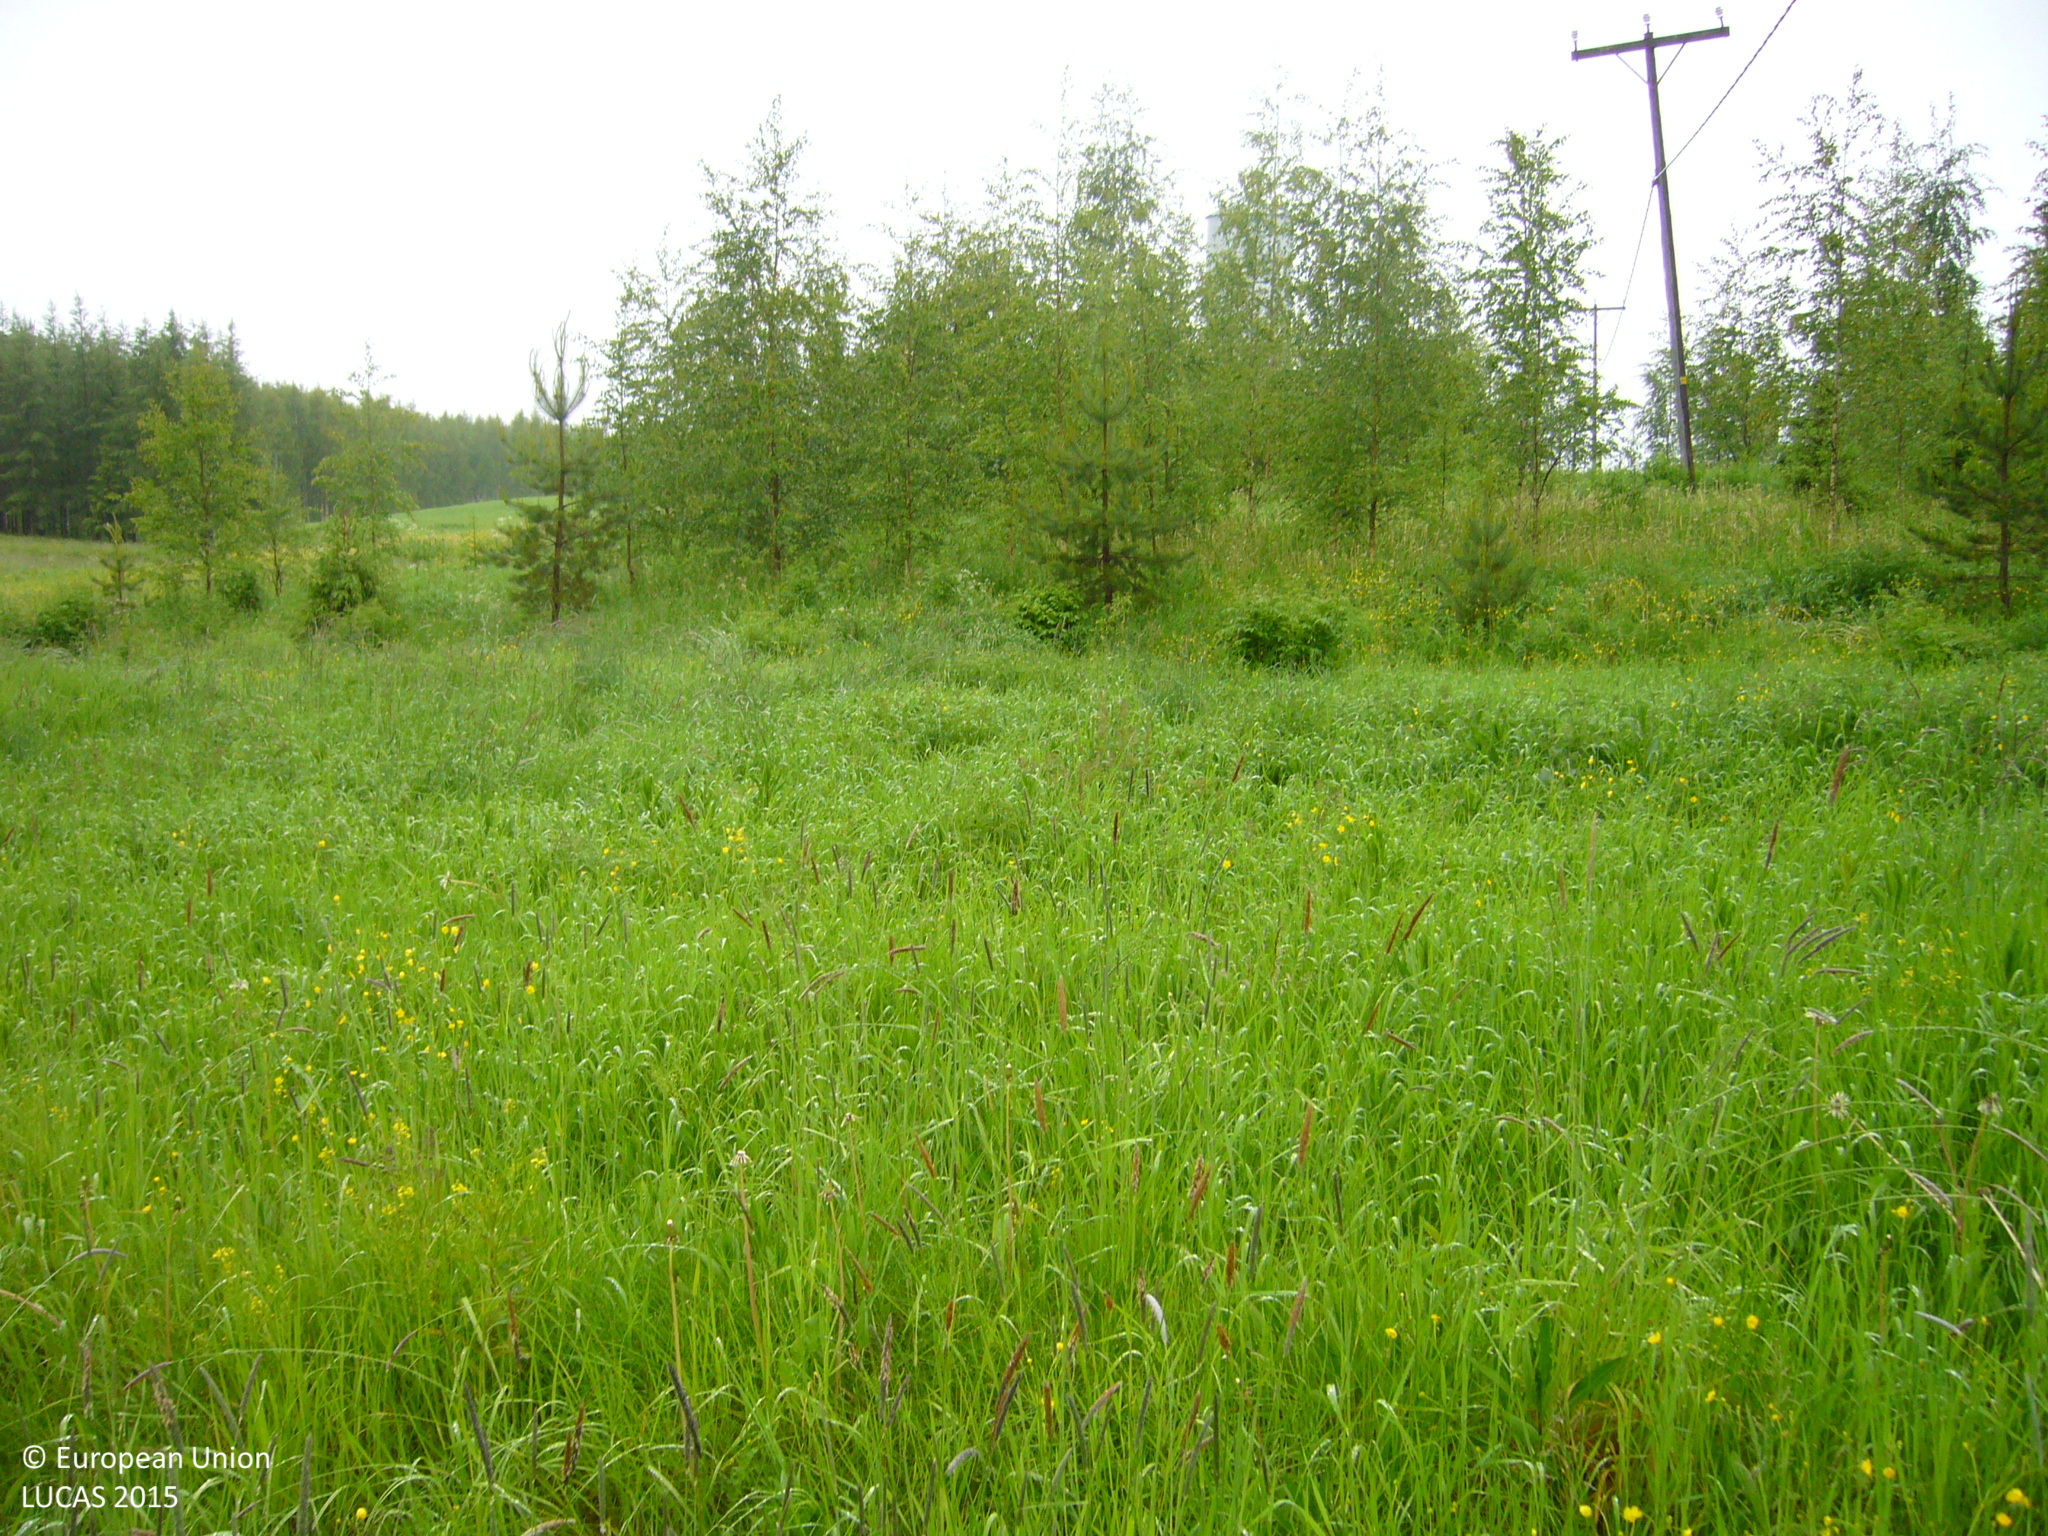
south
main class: Grassland
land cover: Grassland without tree/shrub cover
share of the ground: > 75 %
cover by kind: herbaceous plants 100 %
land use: Agriculture (excluding fallow land and kitchen gardens)
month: June
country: FI
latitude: 63.8309
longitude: 25.1493
